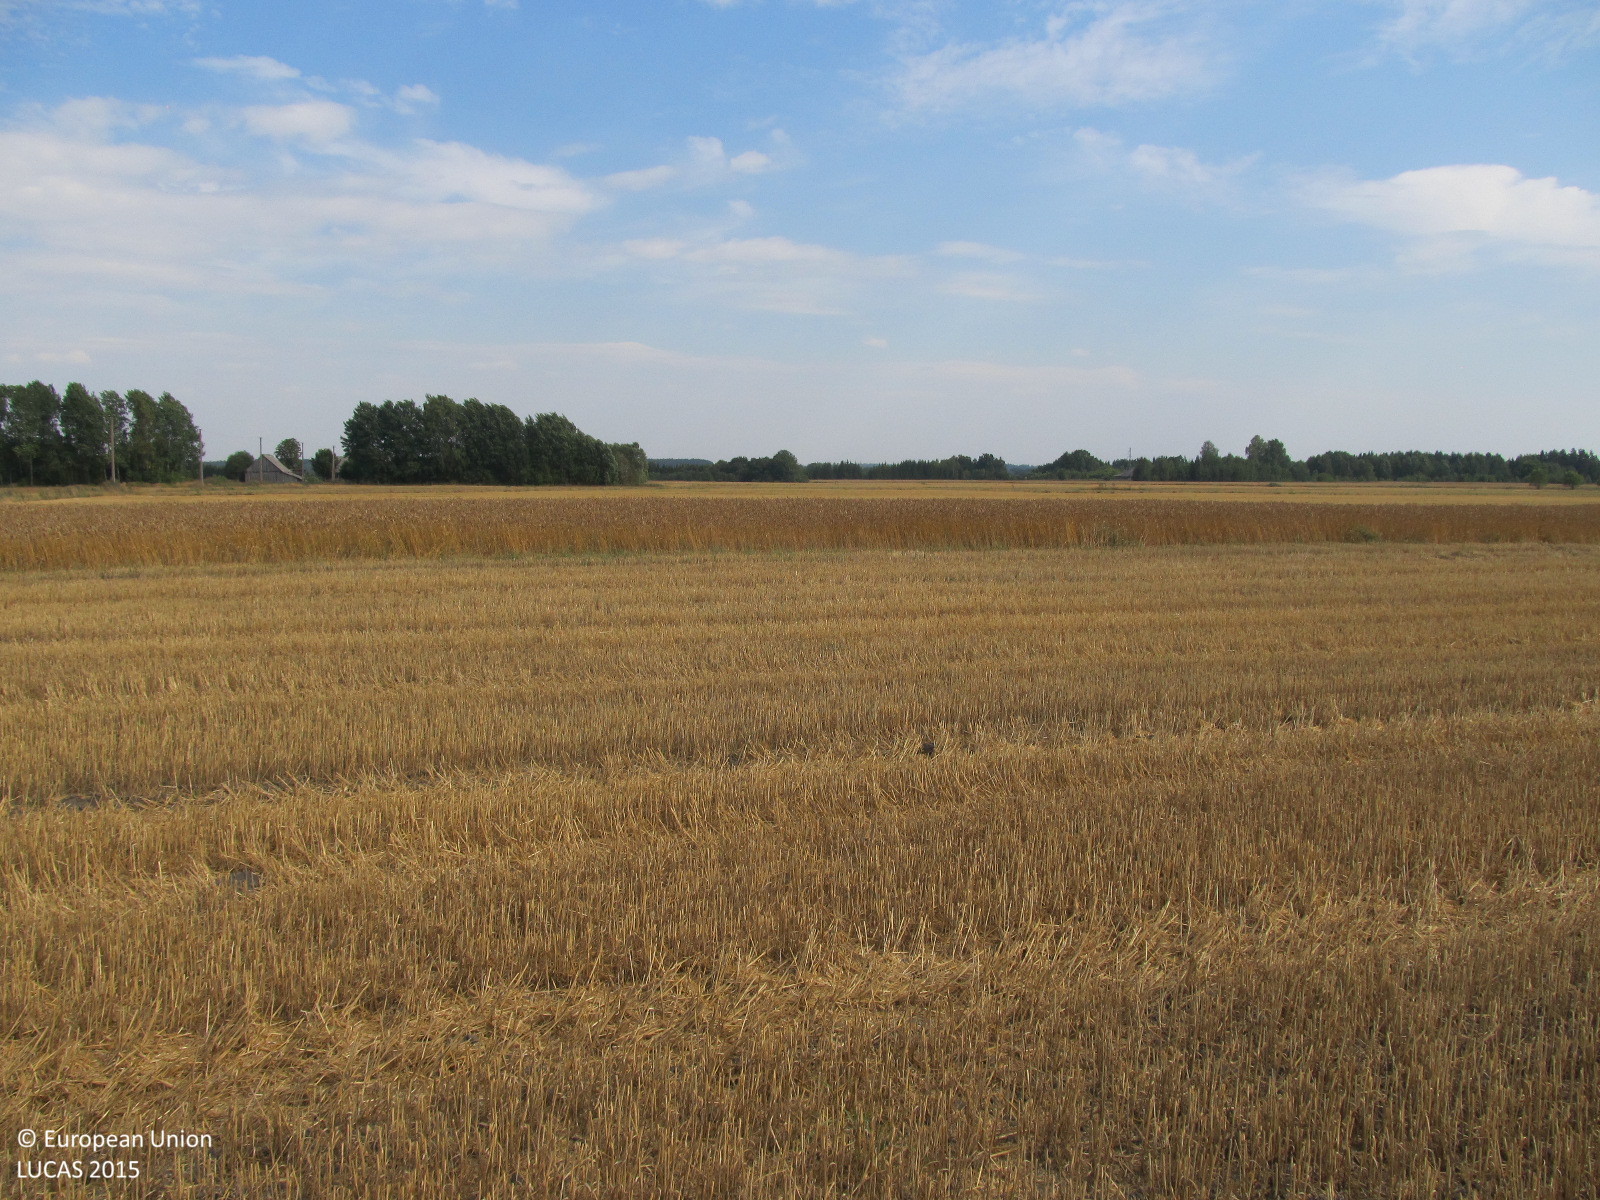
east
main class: Cropland
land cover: Barley
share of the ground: > 75 %
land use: Agriculture (excluding fallow land and kitchen gardens)
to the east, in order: Barley; Common wheat; Barley; Dry pulses; Common wheat
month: August
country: LT
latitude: 55.6627
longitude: 23.0575
